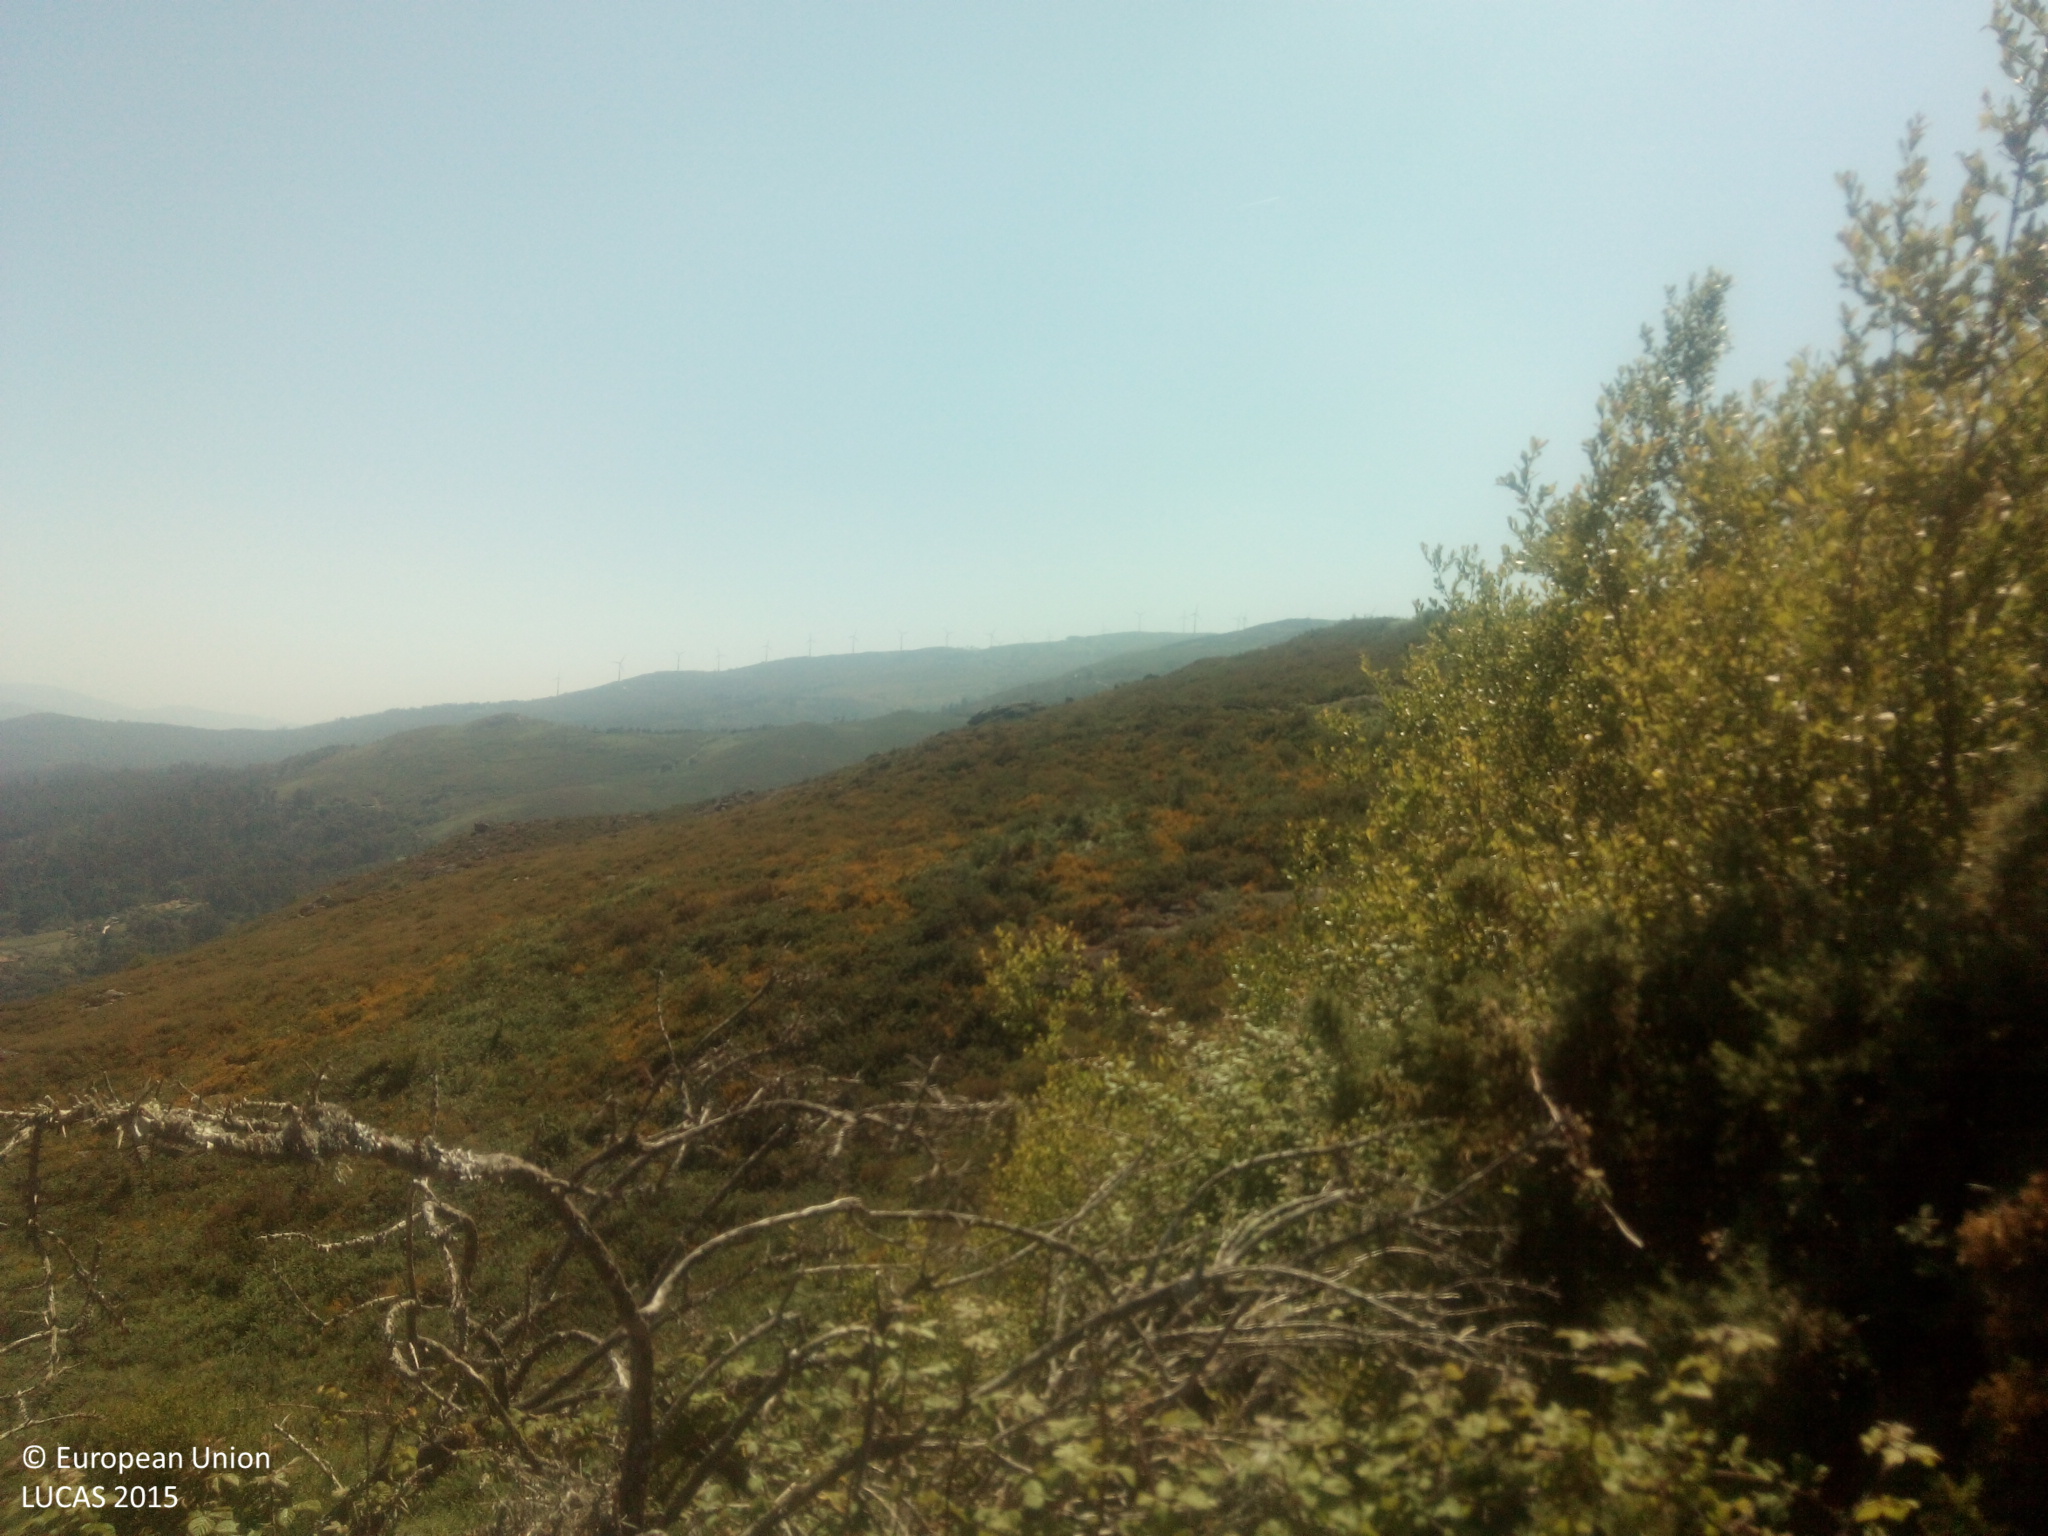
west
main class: Shrubland
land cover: Shrubland without tree cover
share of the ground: > 75 %
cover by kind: shrubs 70 %, consolidated bare surface 30 %
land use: Semi-natural and natural areas not in use
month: June
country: ES
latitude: 42.1869
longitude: -8.3110
